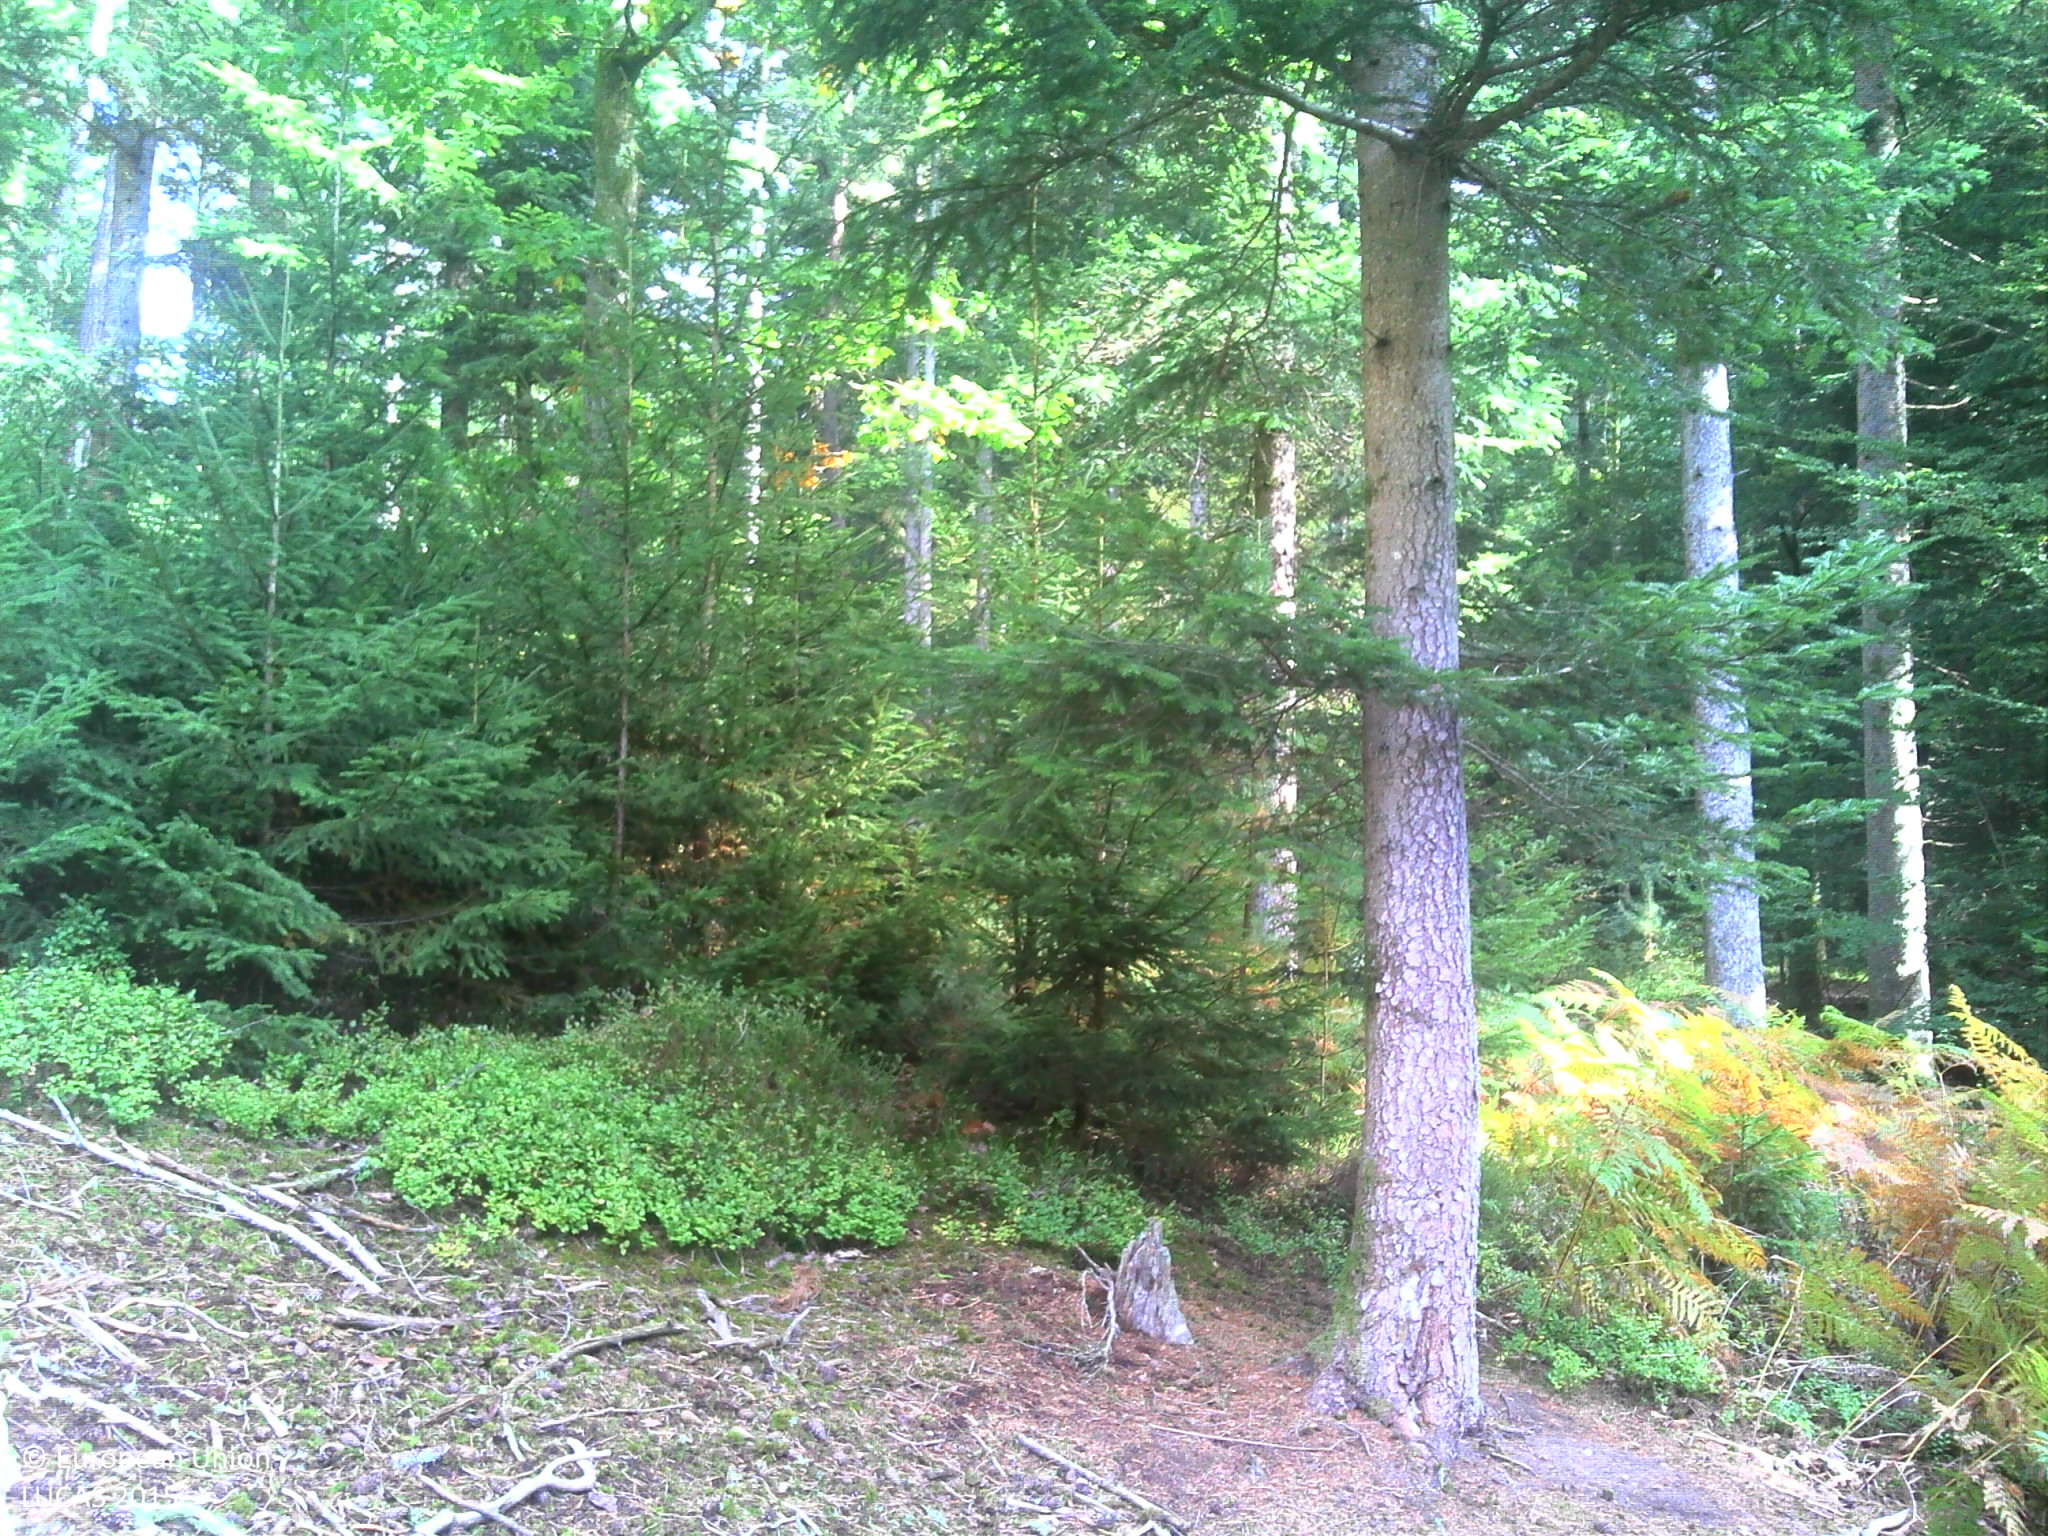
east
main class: Woodland
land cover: Other coniferous woodland
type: hemiboreal forest and nemoral coniferous forest and mixed broadleaved-coniferous forest
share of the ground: > 75 %
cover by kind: coniferous forest trees 85 %, shrubs 5 %, herbaceous plants 5 %, consolidated bare surface 5 %
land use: Forestry
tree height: > 5 m
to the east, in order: Other coniferous woodland; Shrubland with sparse tree cover; Other mixed woodland; Tracks; Other mixed woodland; Spruce dominated mixed woodland
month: September
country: FR
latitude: 48.4299
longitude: 6.8247
